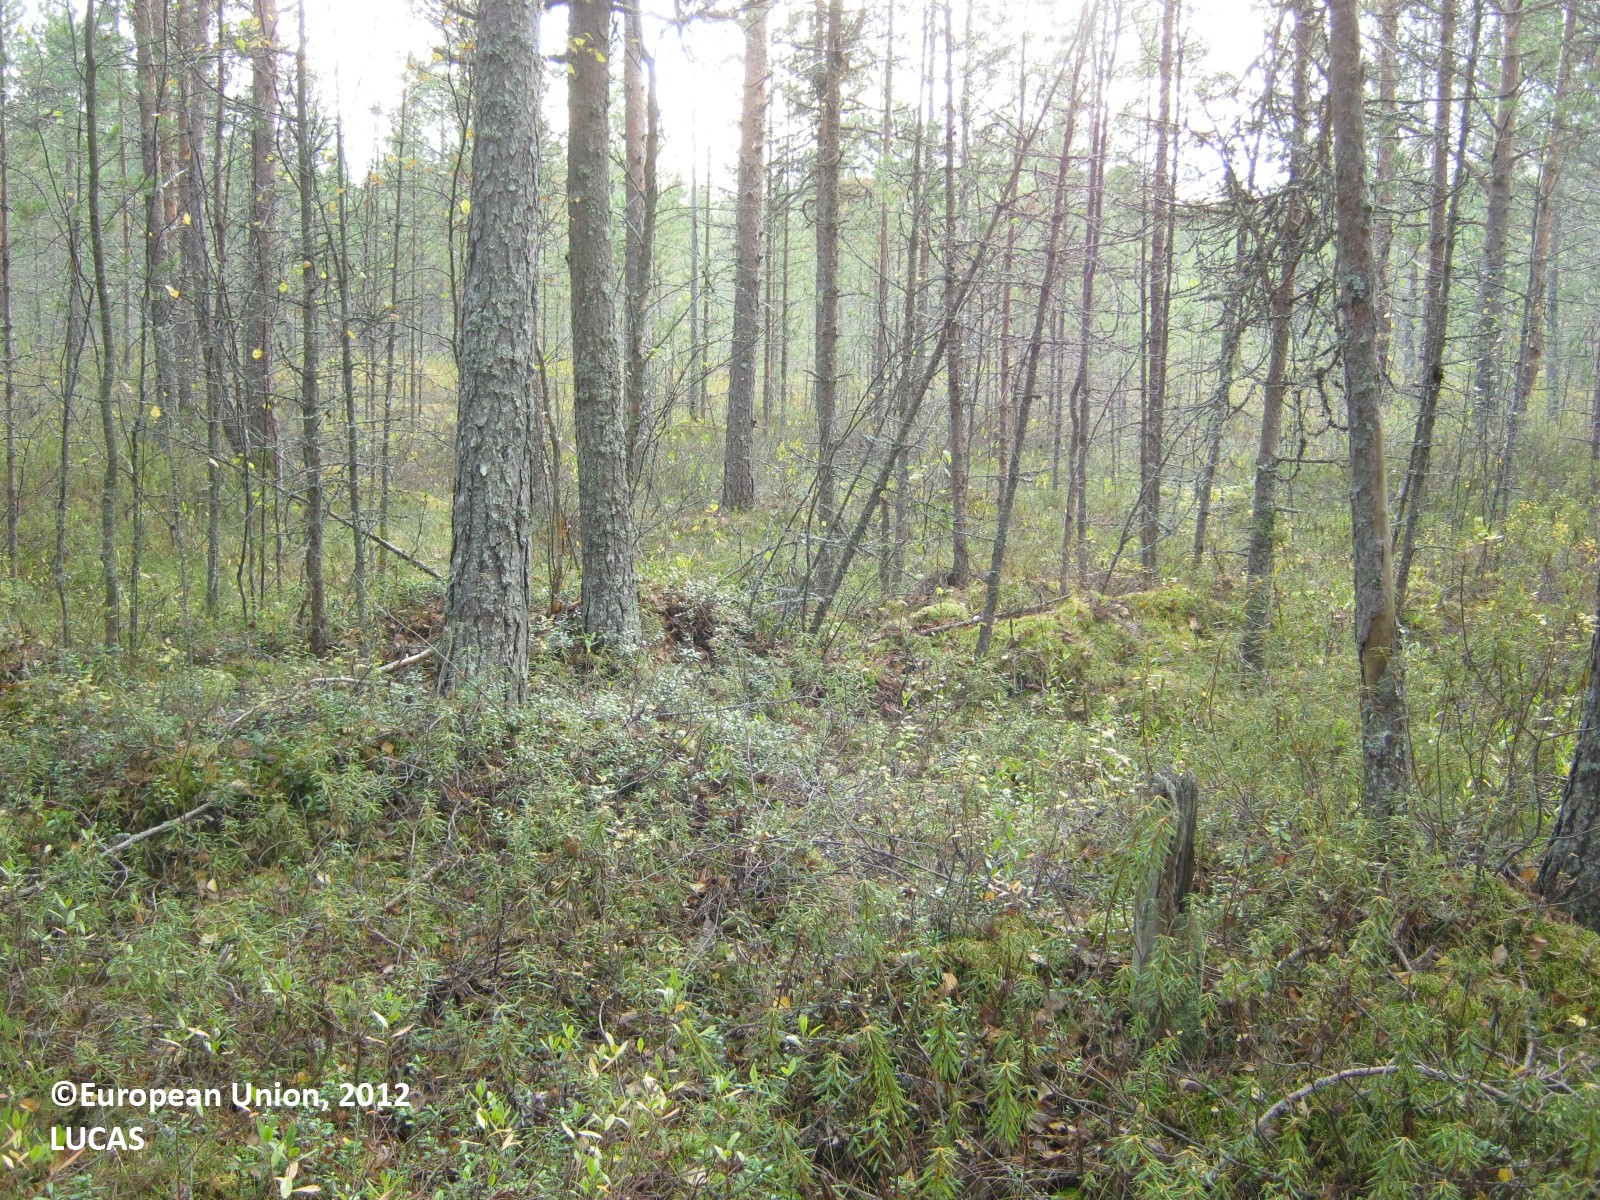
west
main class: Woodland
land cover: Pine dominated coniferous woodland
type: boreal forest
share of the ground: > 75 %
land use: Forestry
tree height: > 5 m
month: September
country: FI
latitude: 63.4985
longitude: 25.8786
